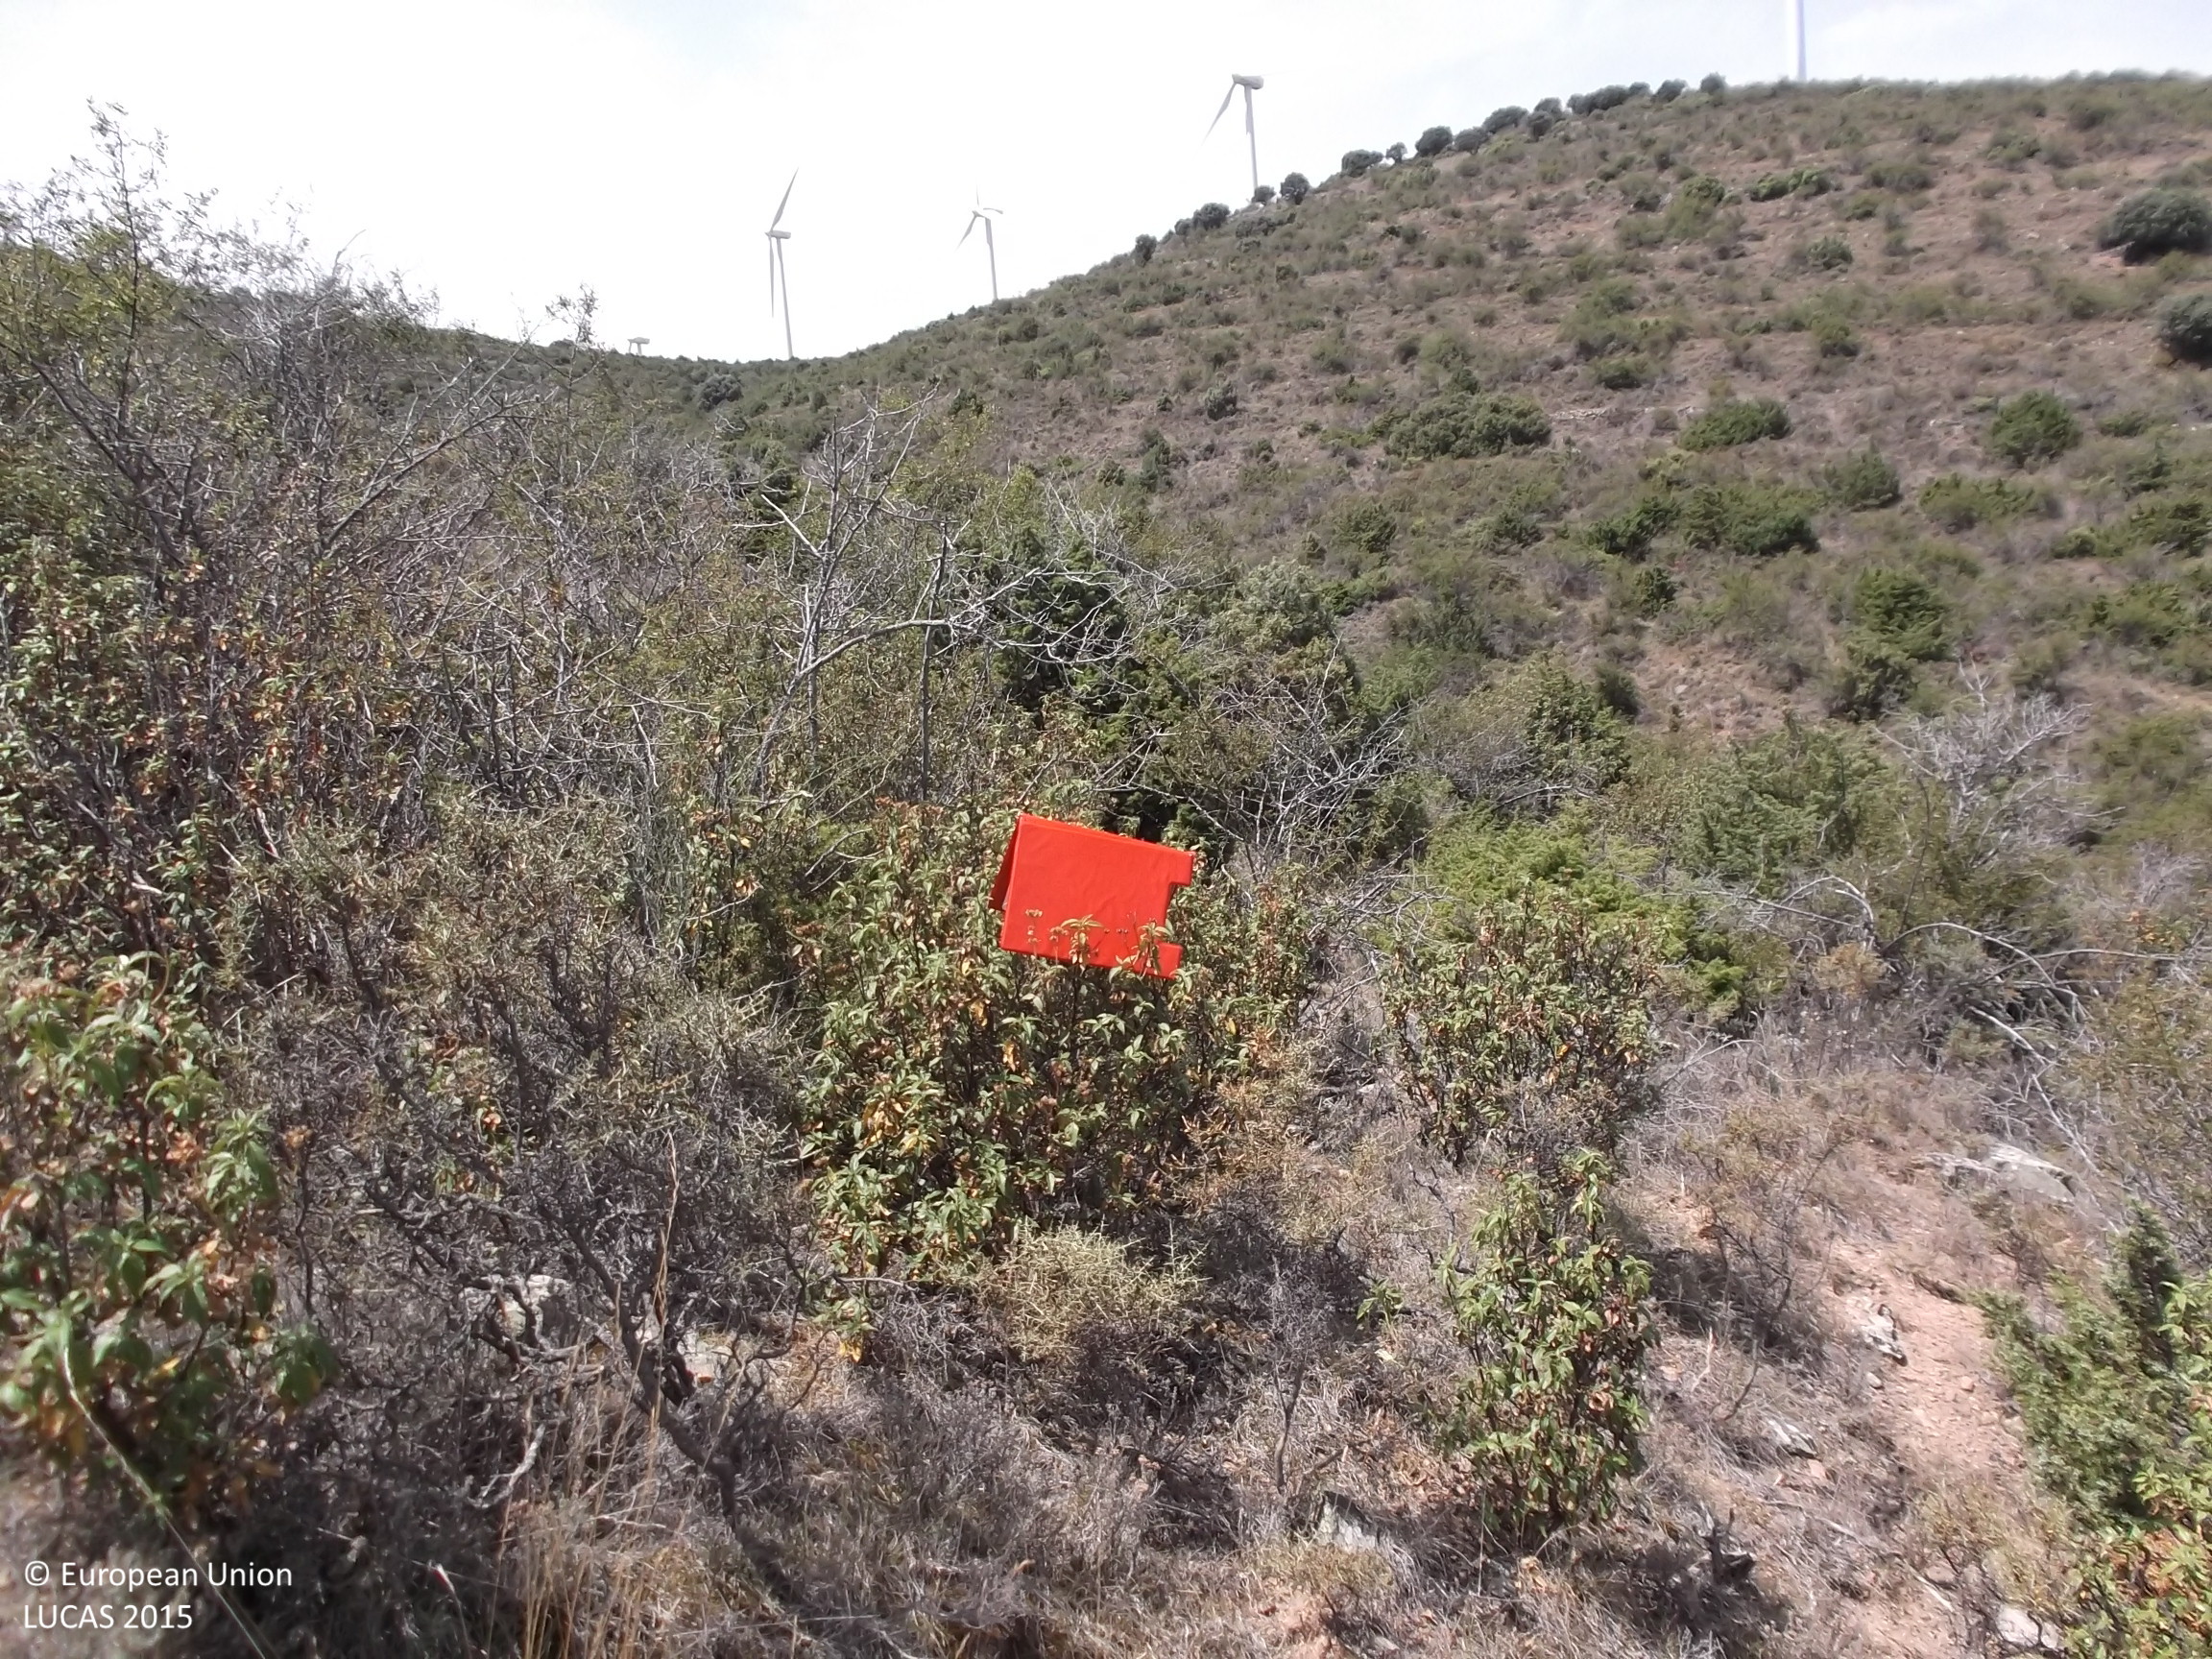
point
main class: Shrubland
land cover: Shrubland with sparse tree cover
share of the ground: > 75 %
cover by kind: shrubs 80 %, unconsolidated bare surface 15 %, broadleaved forest trees 5 %
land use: Agriculture (excluding fallow land and kitchen gardens)
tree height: < 5 m
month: July
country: ES
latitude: 42.0227
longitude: -2.0527
